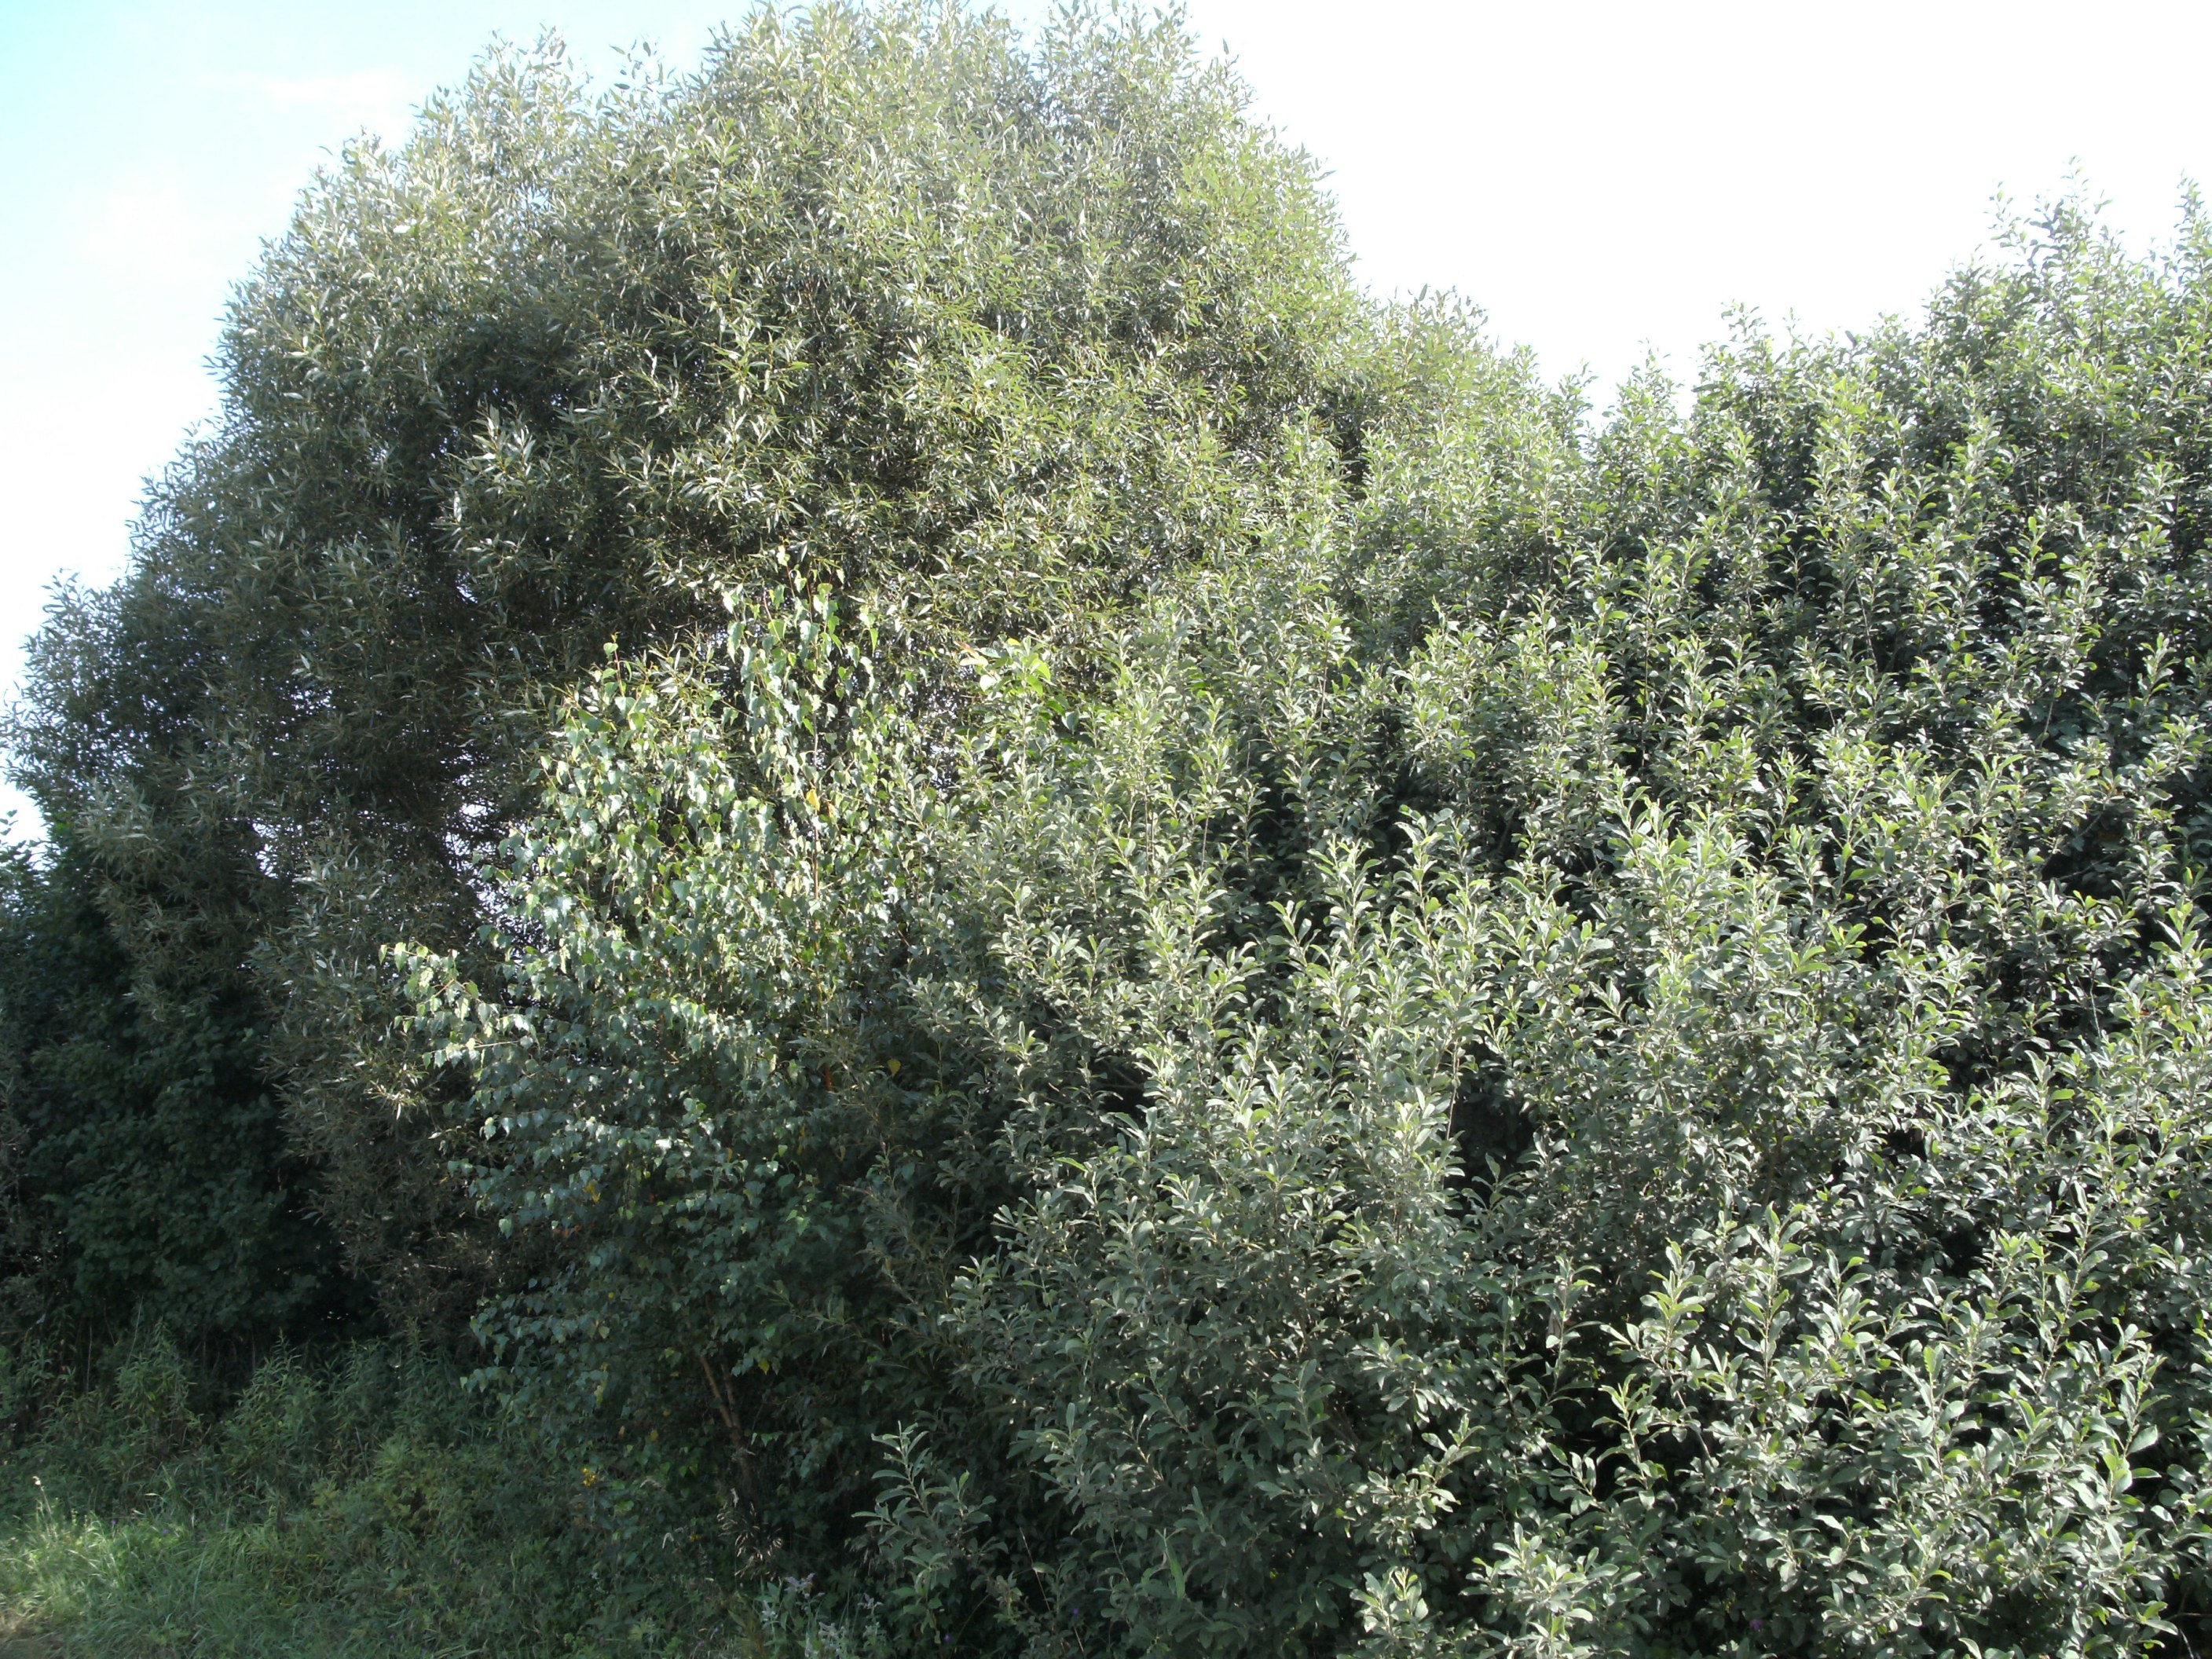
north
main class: Grassland
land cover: Grassland without tree/shrub cover
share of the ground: > 75 %
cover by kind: herbaceous plants 100 %
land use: Agriculture (excluding fallow land and kitchen gardens)
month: July
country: AT
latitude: 46.5700
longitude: 14.7599
